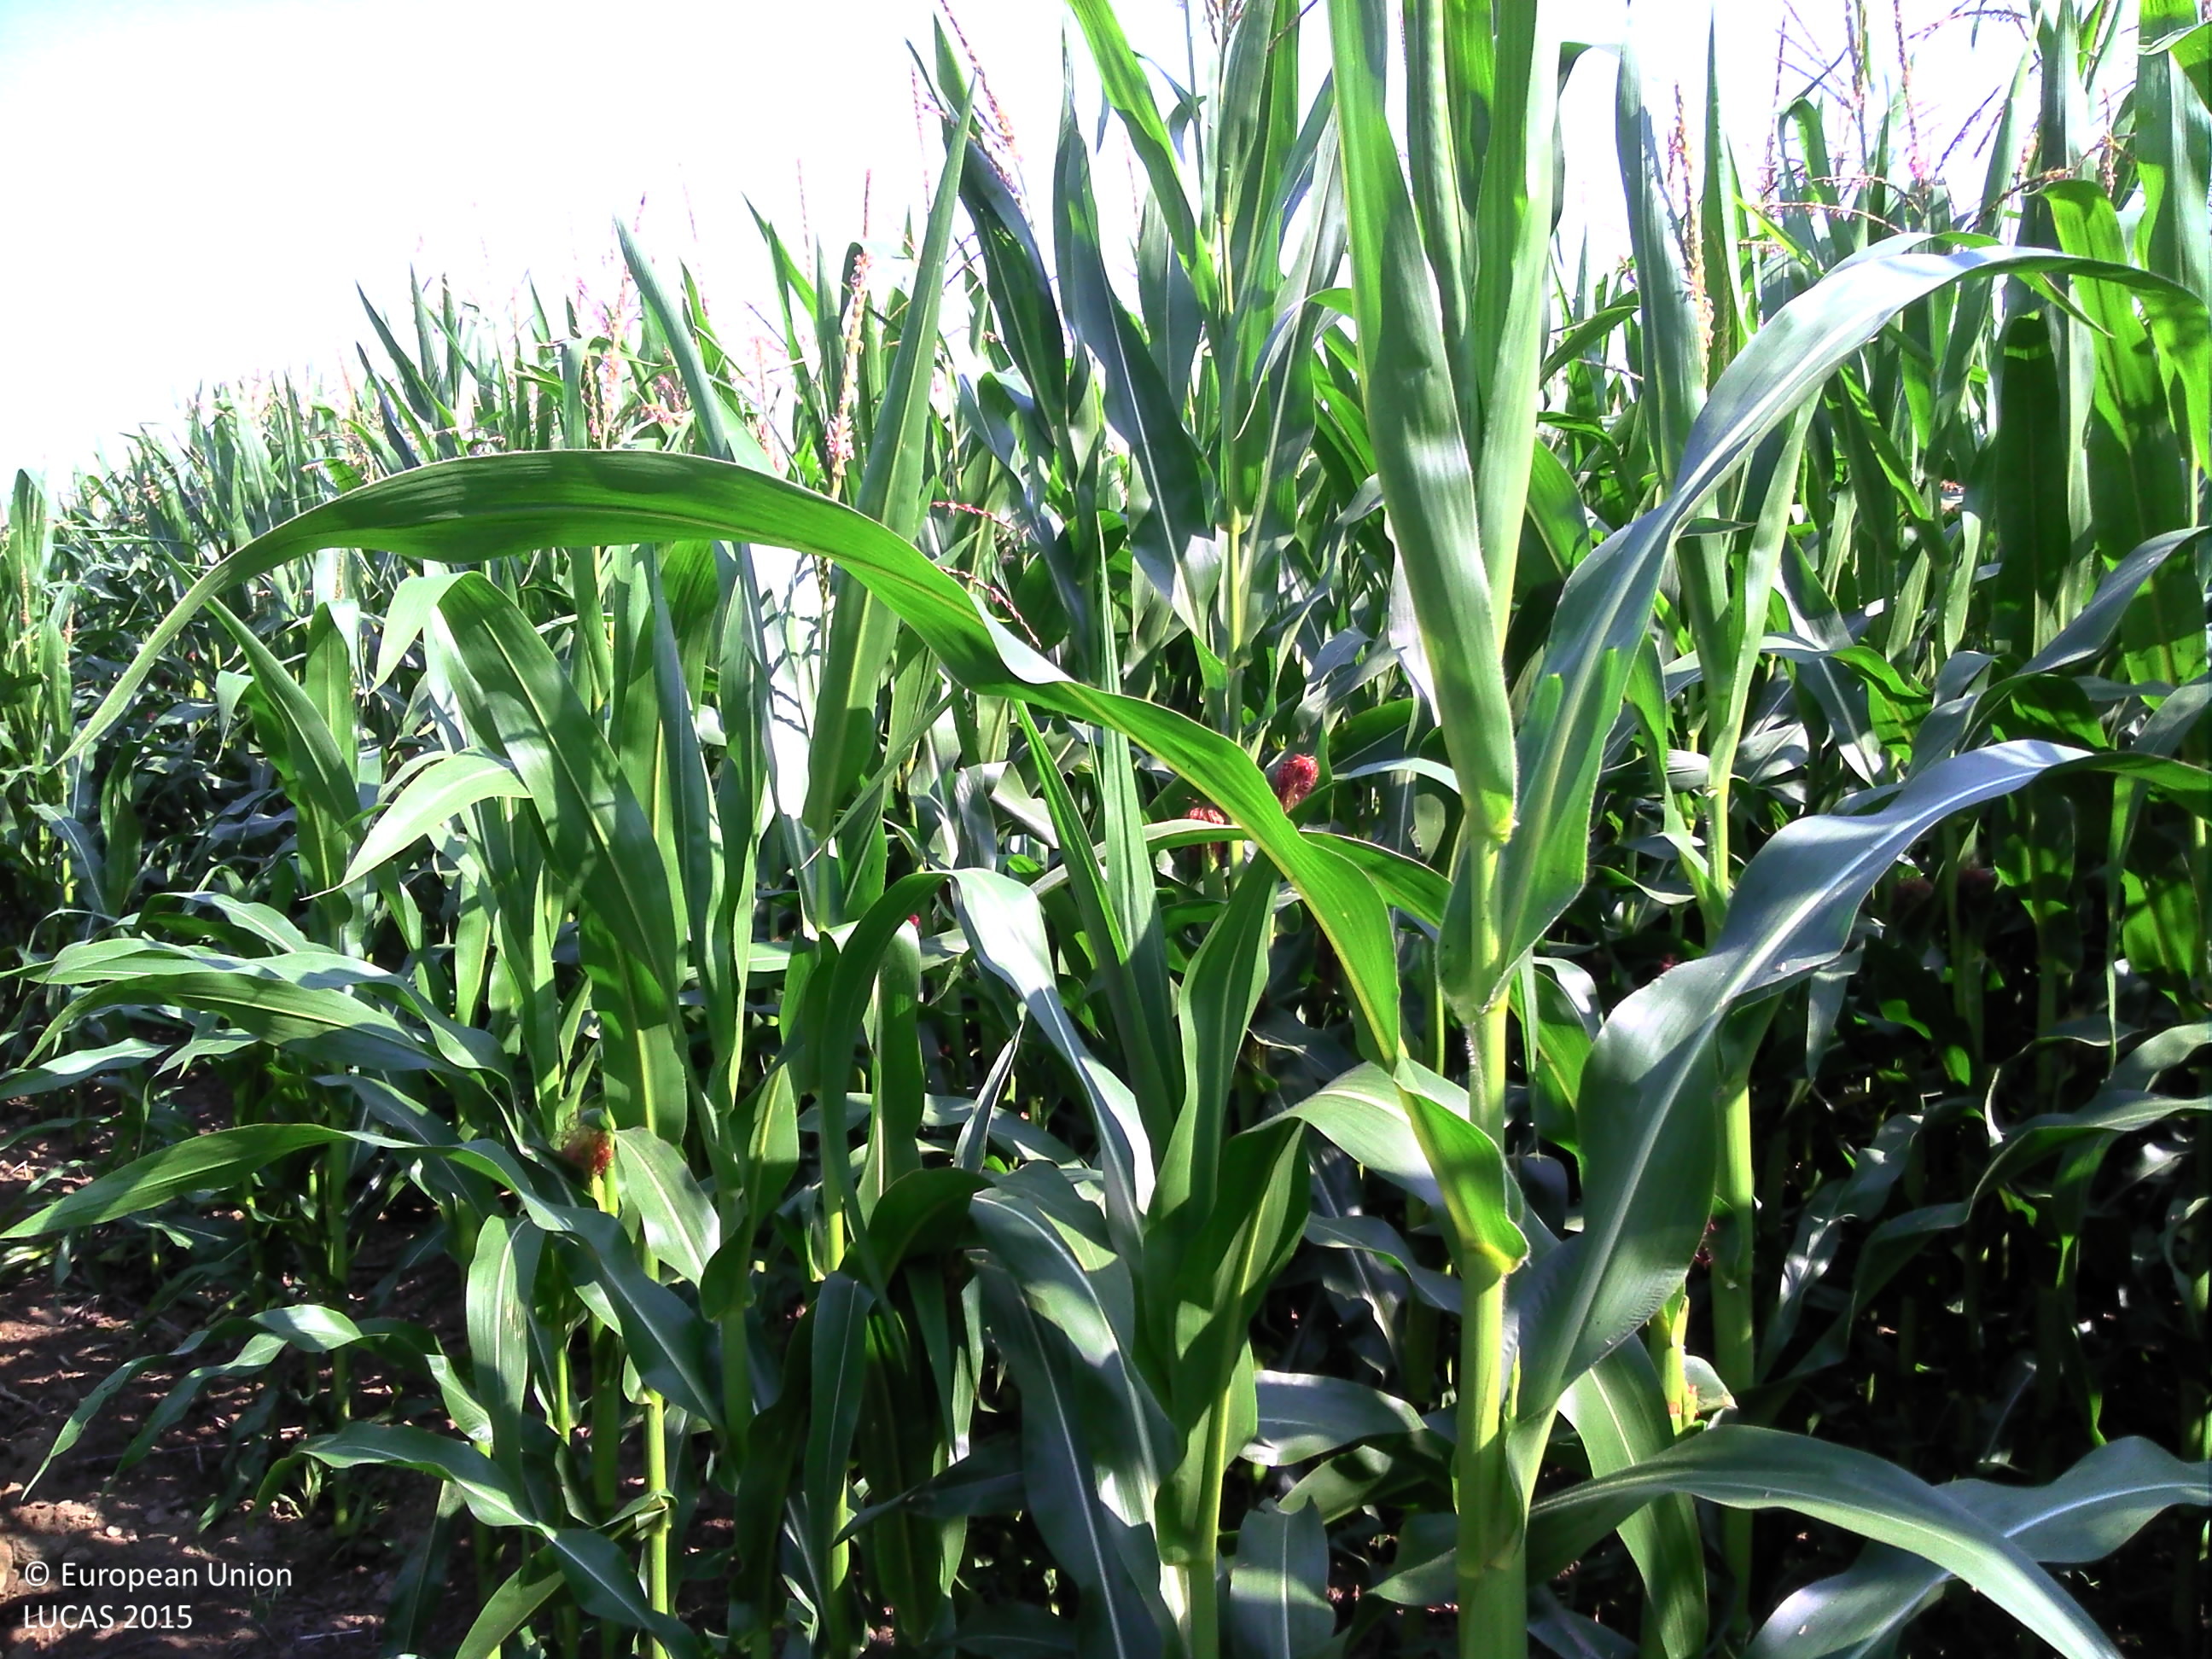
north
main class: Cropland
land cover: Maize
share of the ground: > 75 %
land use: Agriculture (excluding fallow land and kitchen gardens)
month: August
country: BE
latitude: 50.7208
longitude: 5.8485
